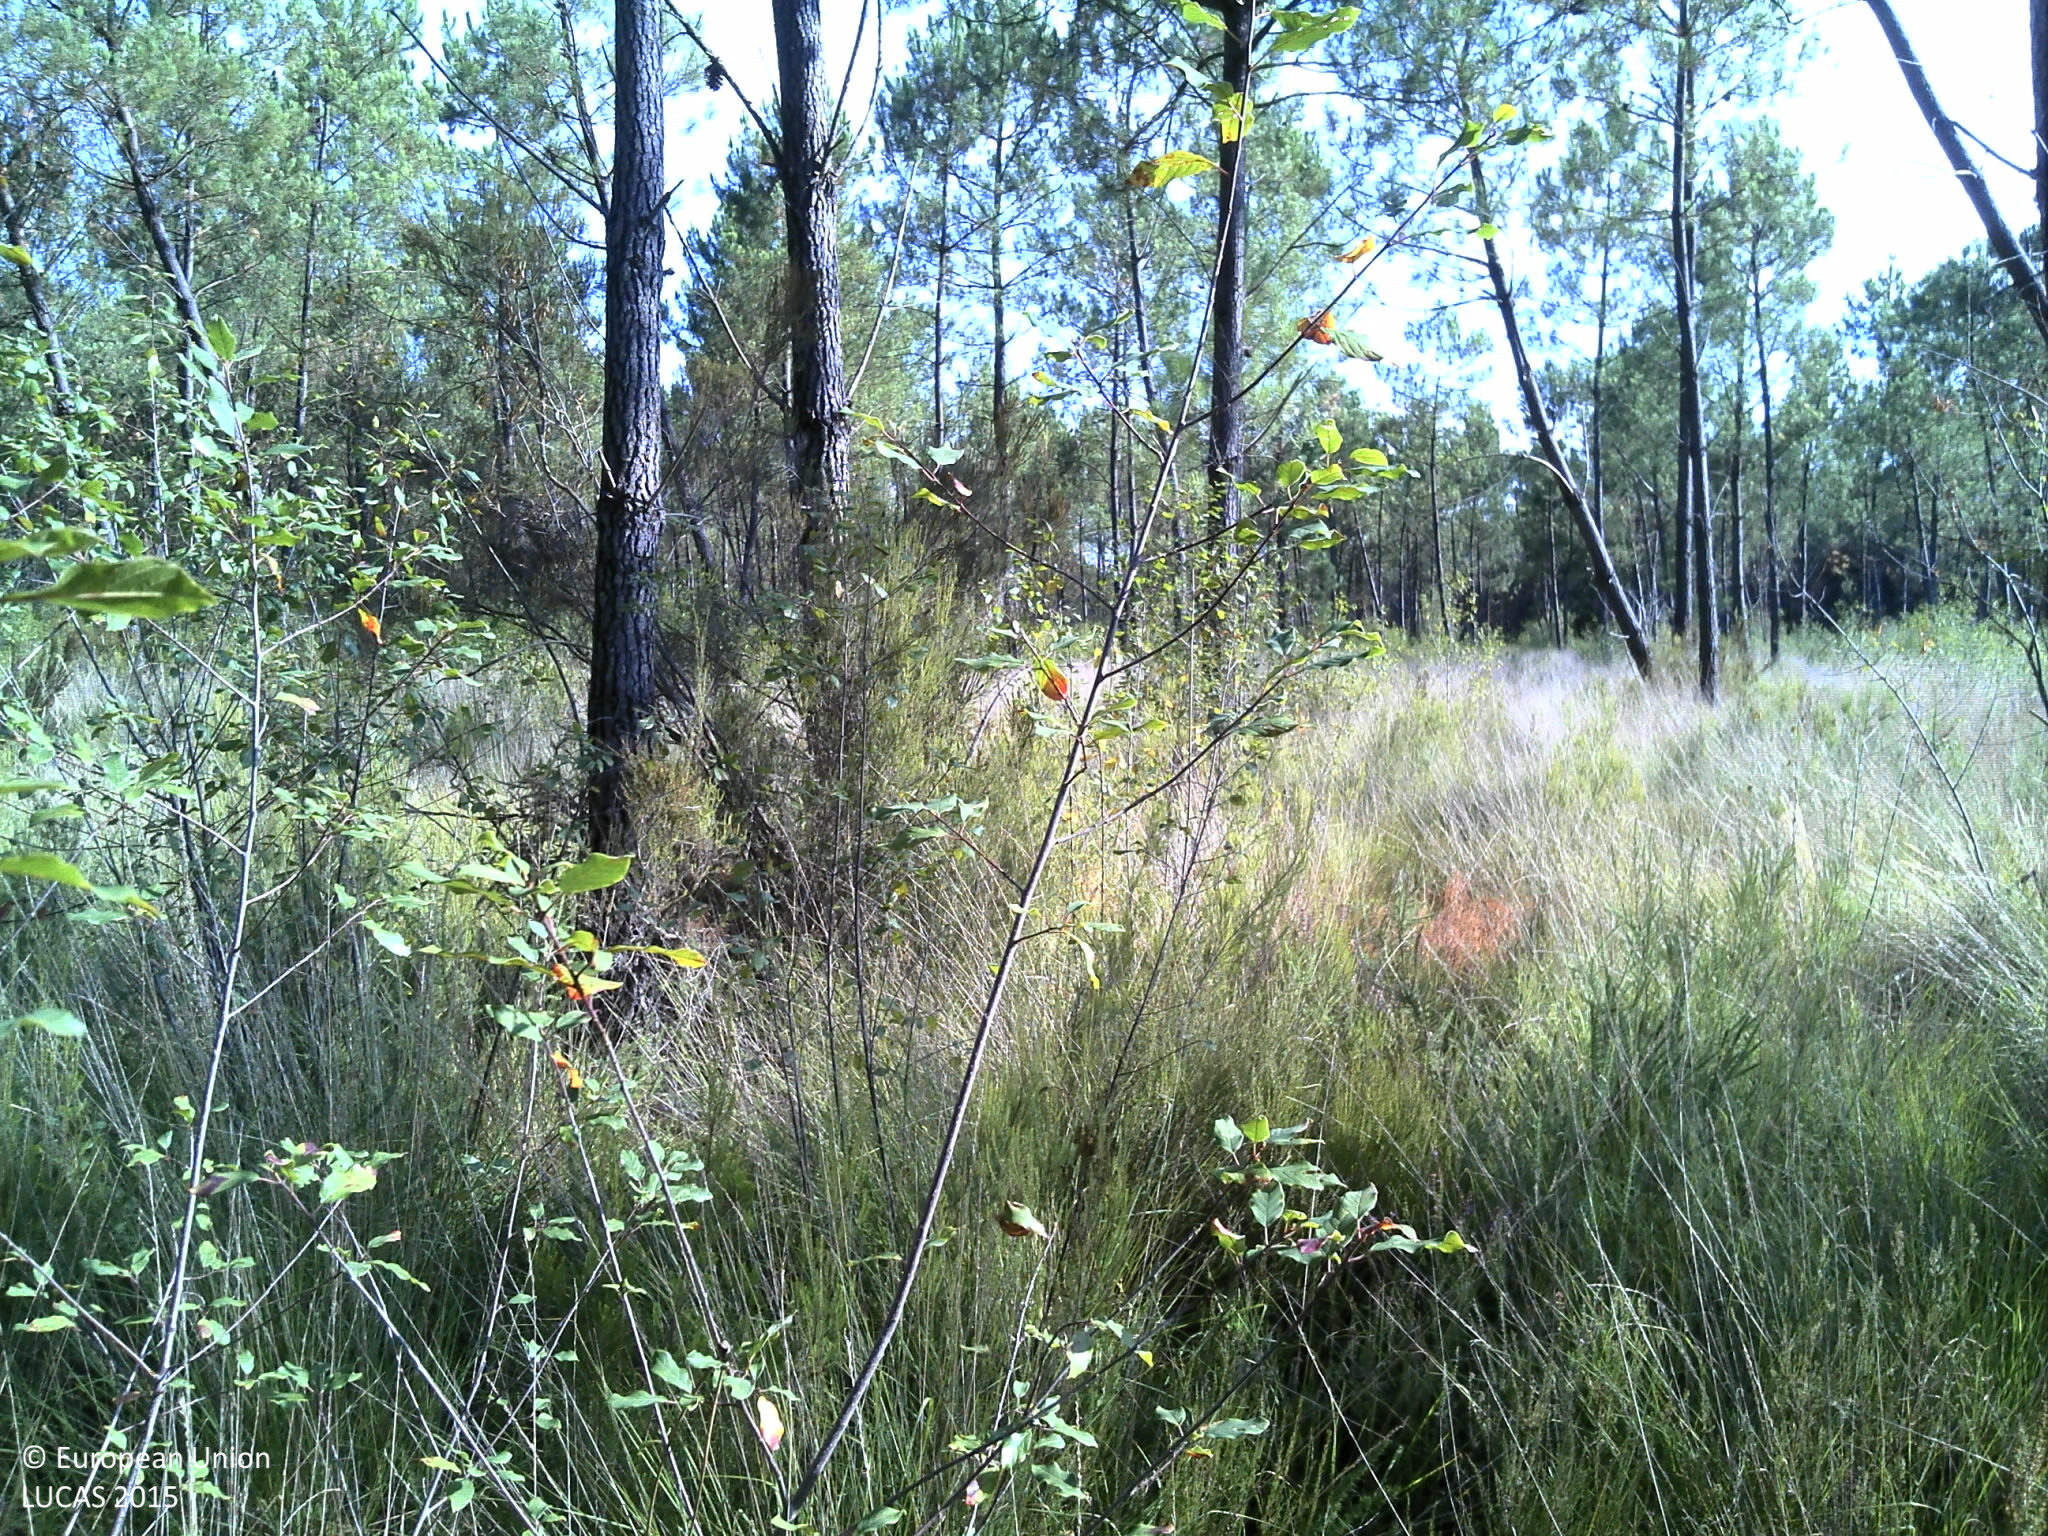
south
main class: Woodland
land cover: Pine dominated coniferous woodland
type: coniferous forest of the mediterranean region
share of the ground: > 75 %
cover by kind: coniferous forest trees 60 %, shrubs 30 %, herbaceous plants 5 %, lichens and mosses 5 %
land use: Forestry
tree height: > 5 m
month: July
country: FR
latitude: 44.5357
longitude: -0.5752
